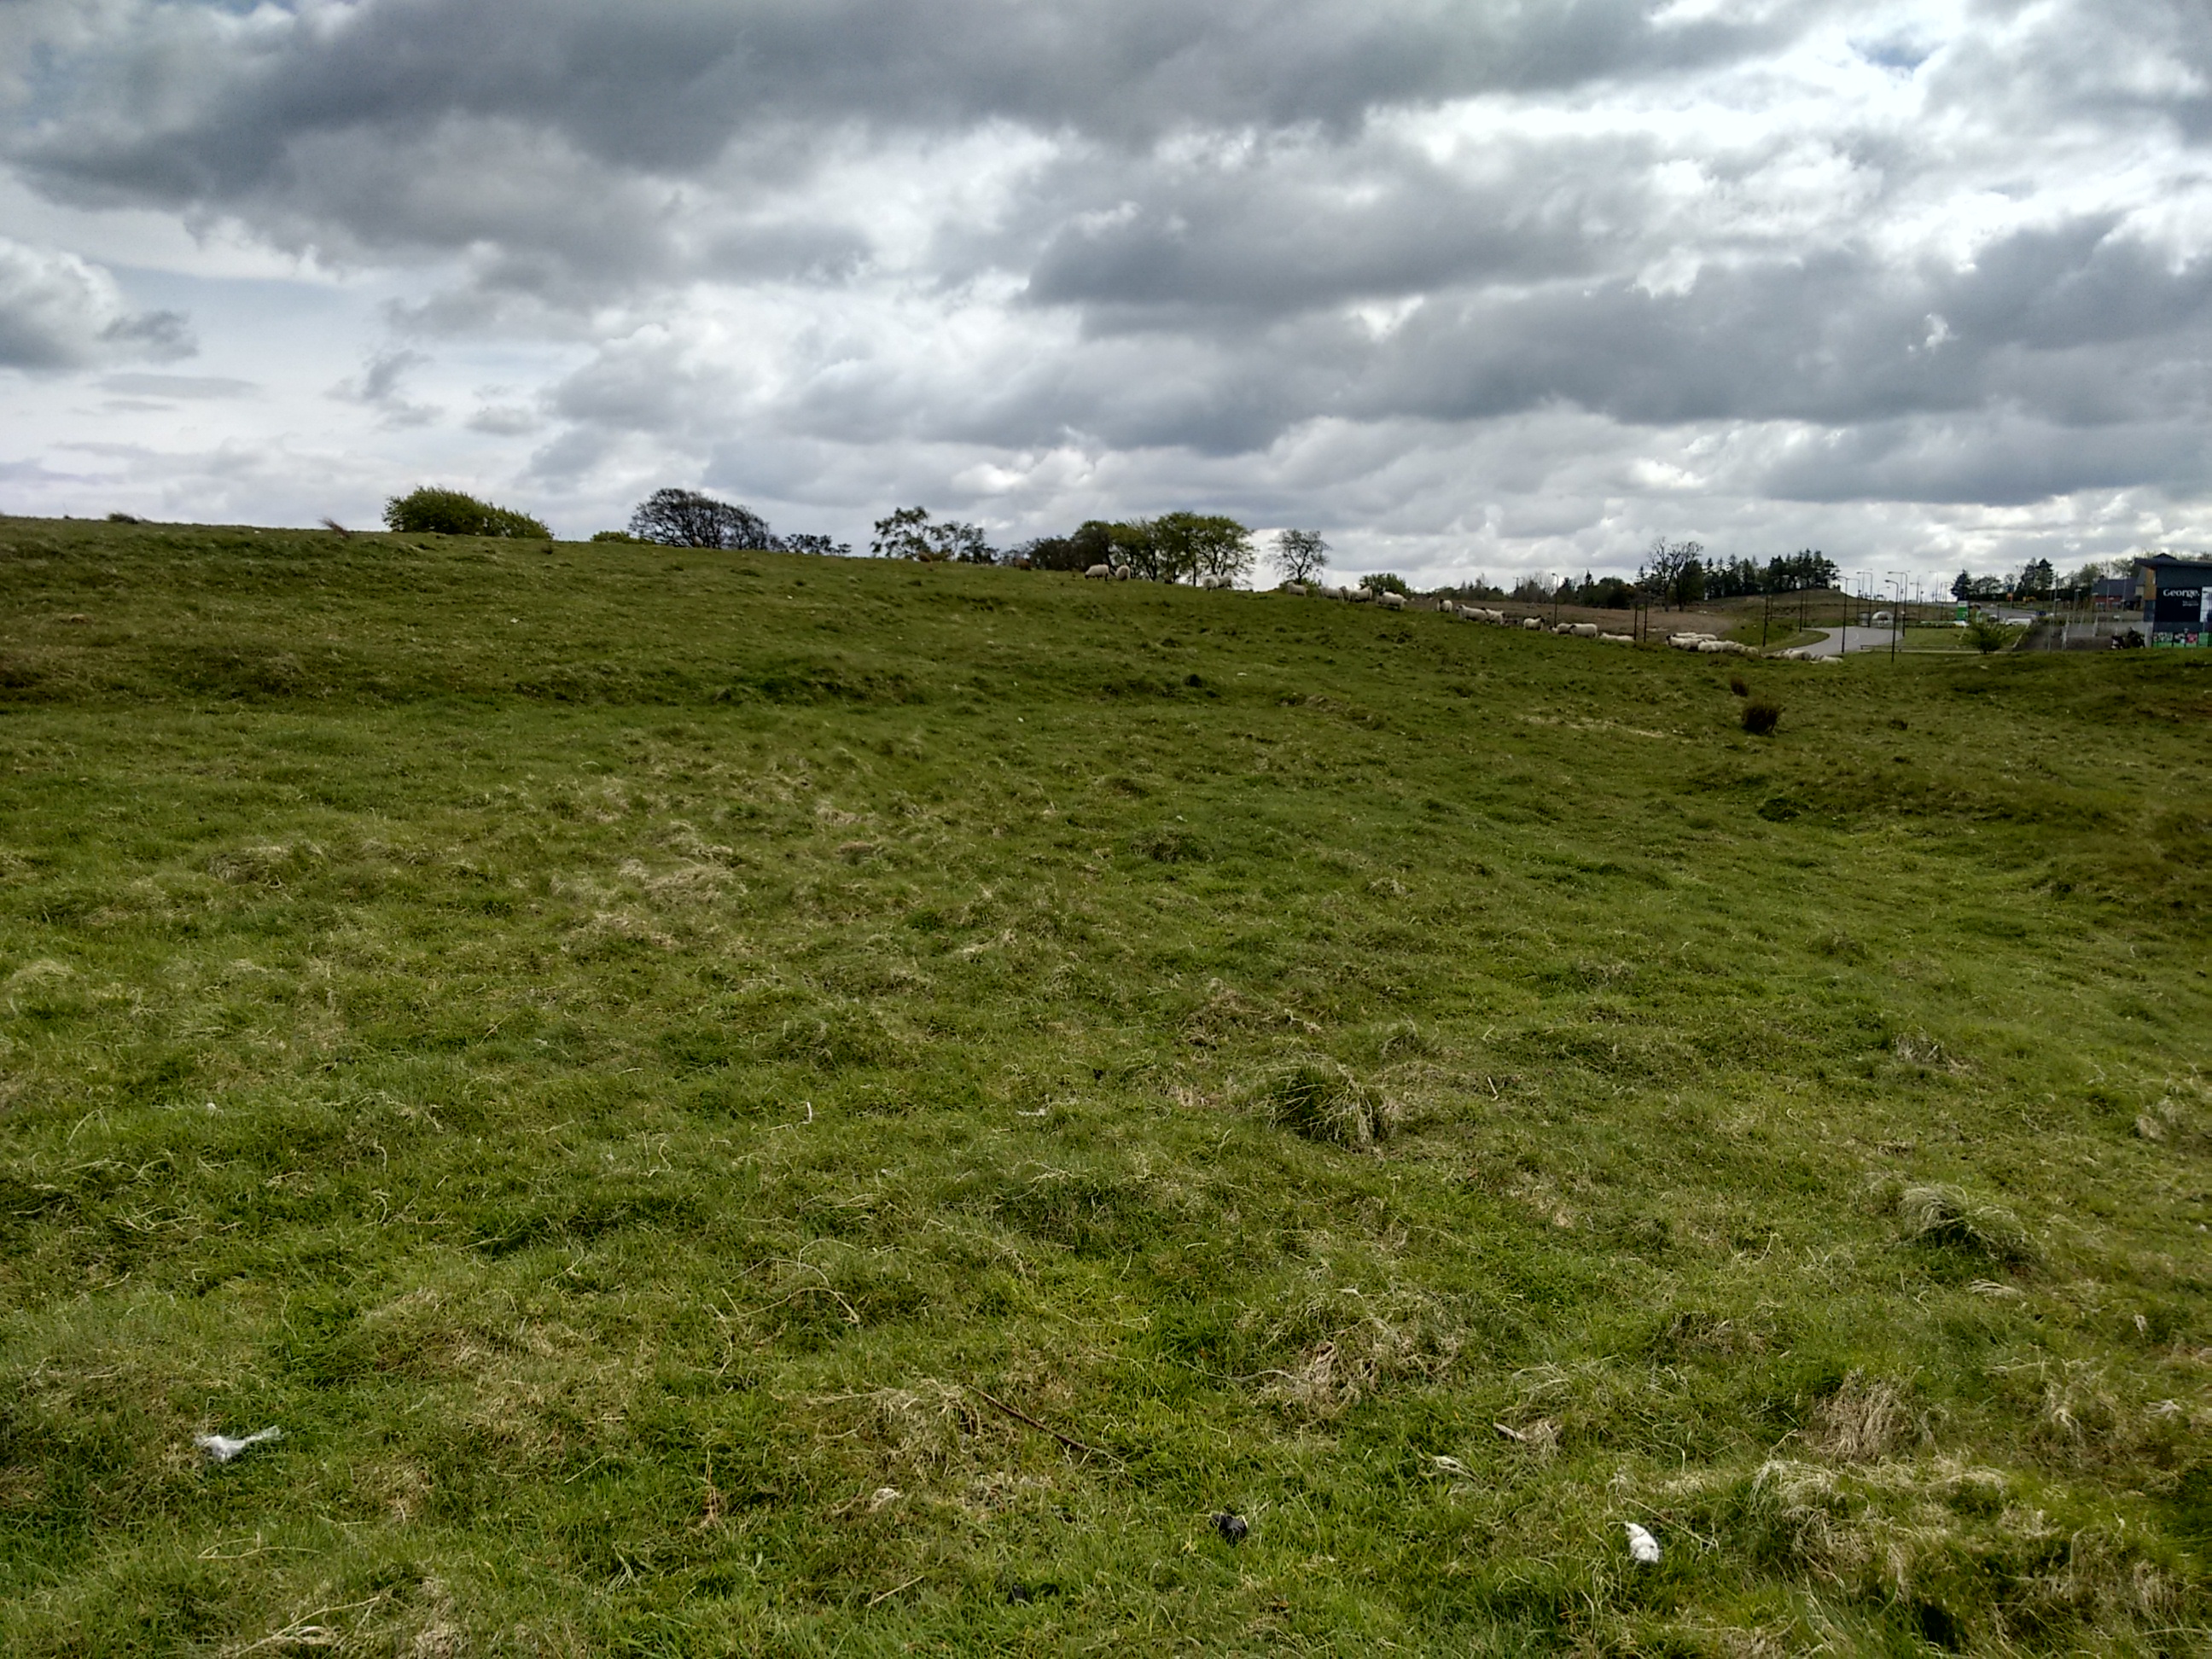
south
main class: Grassland
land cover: Grassland without tree/shrub cover
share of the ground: > 75 %
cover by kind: herbaceous plants 95 %, shrubs 5 %
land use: Agriculture (excluding fallow land and kitchen gardens)
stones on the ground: < 10 %
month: May
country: GB
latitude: 55.8880
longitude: -3.6875
